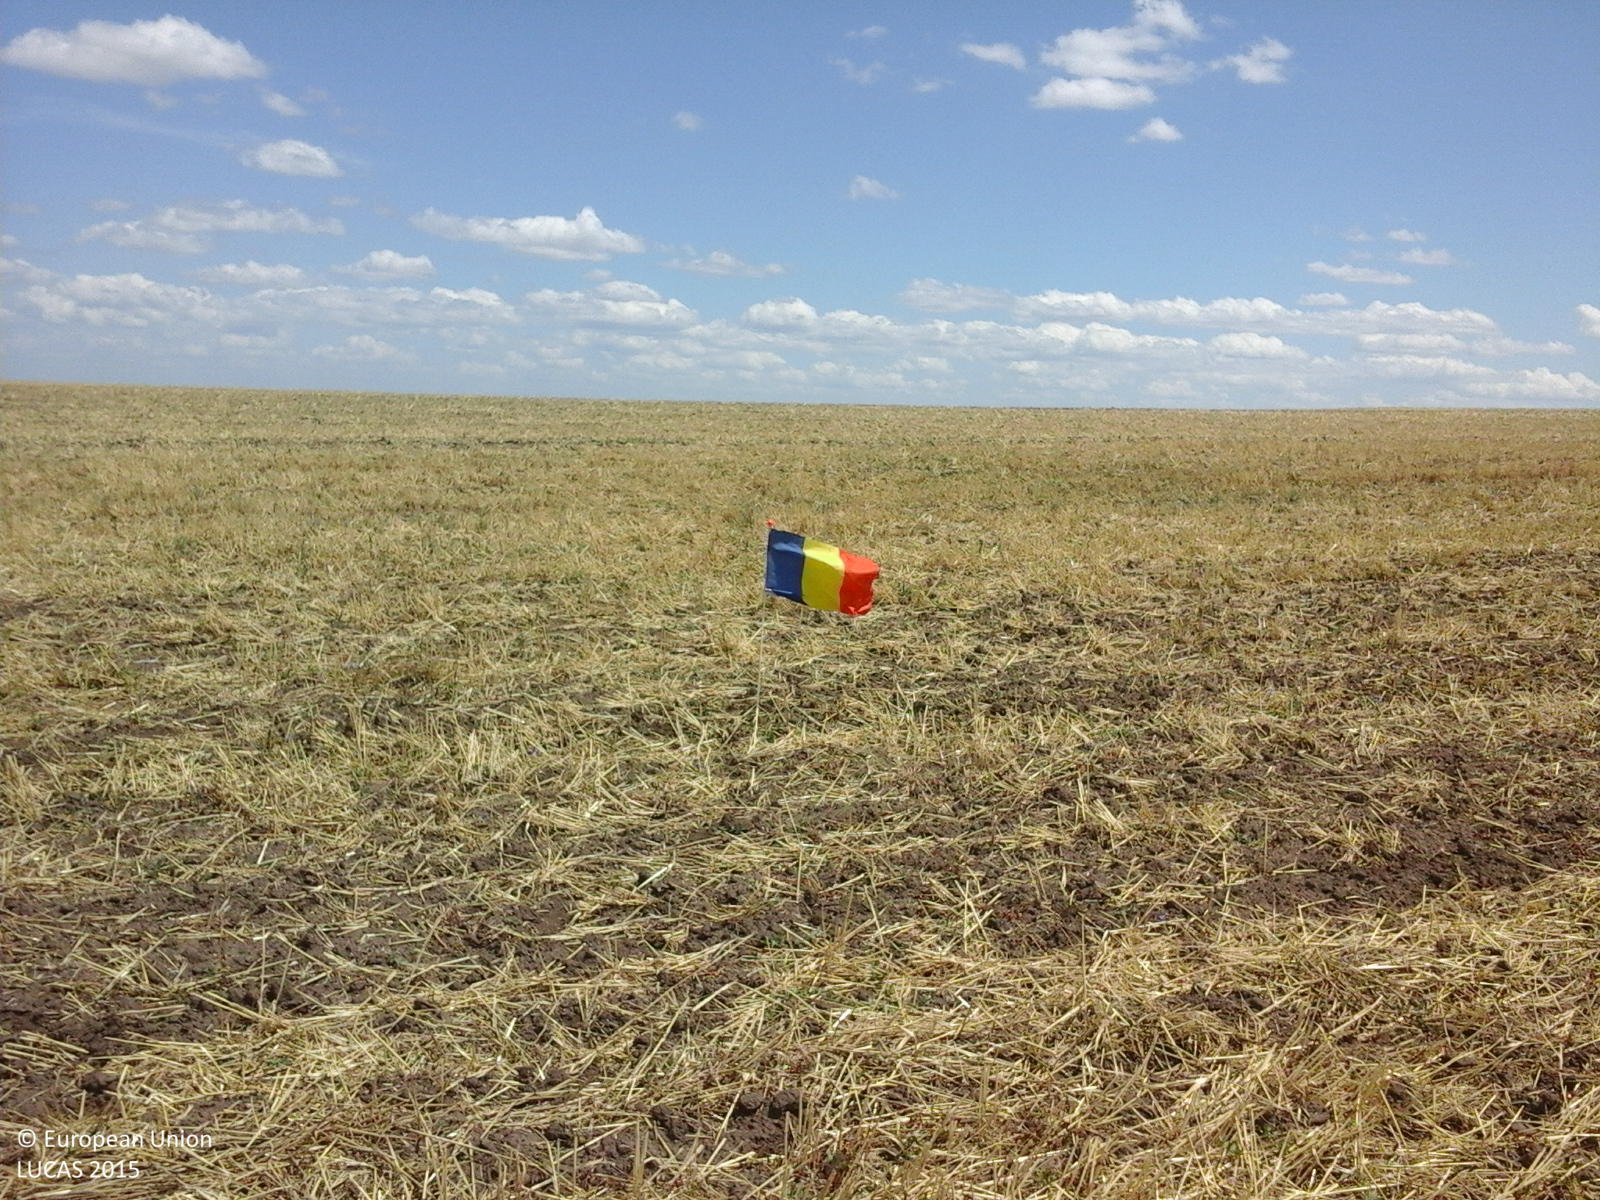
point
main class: Cropland
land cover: Common wheat
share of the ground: 25 - 50 %
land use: Agriculture (excluding fallow land and kitchen gardens)
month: July
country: RO
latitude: 45.9127
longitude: 27.6835
